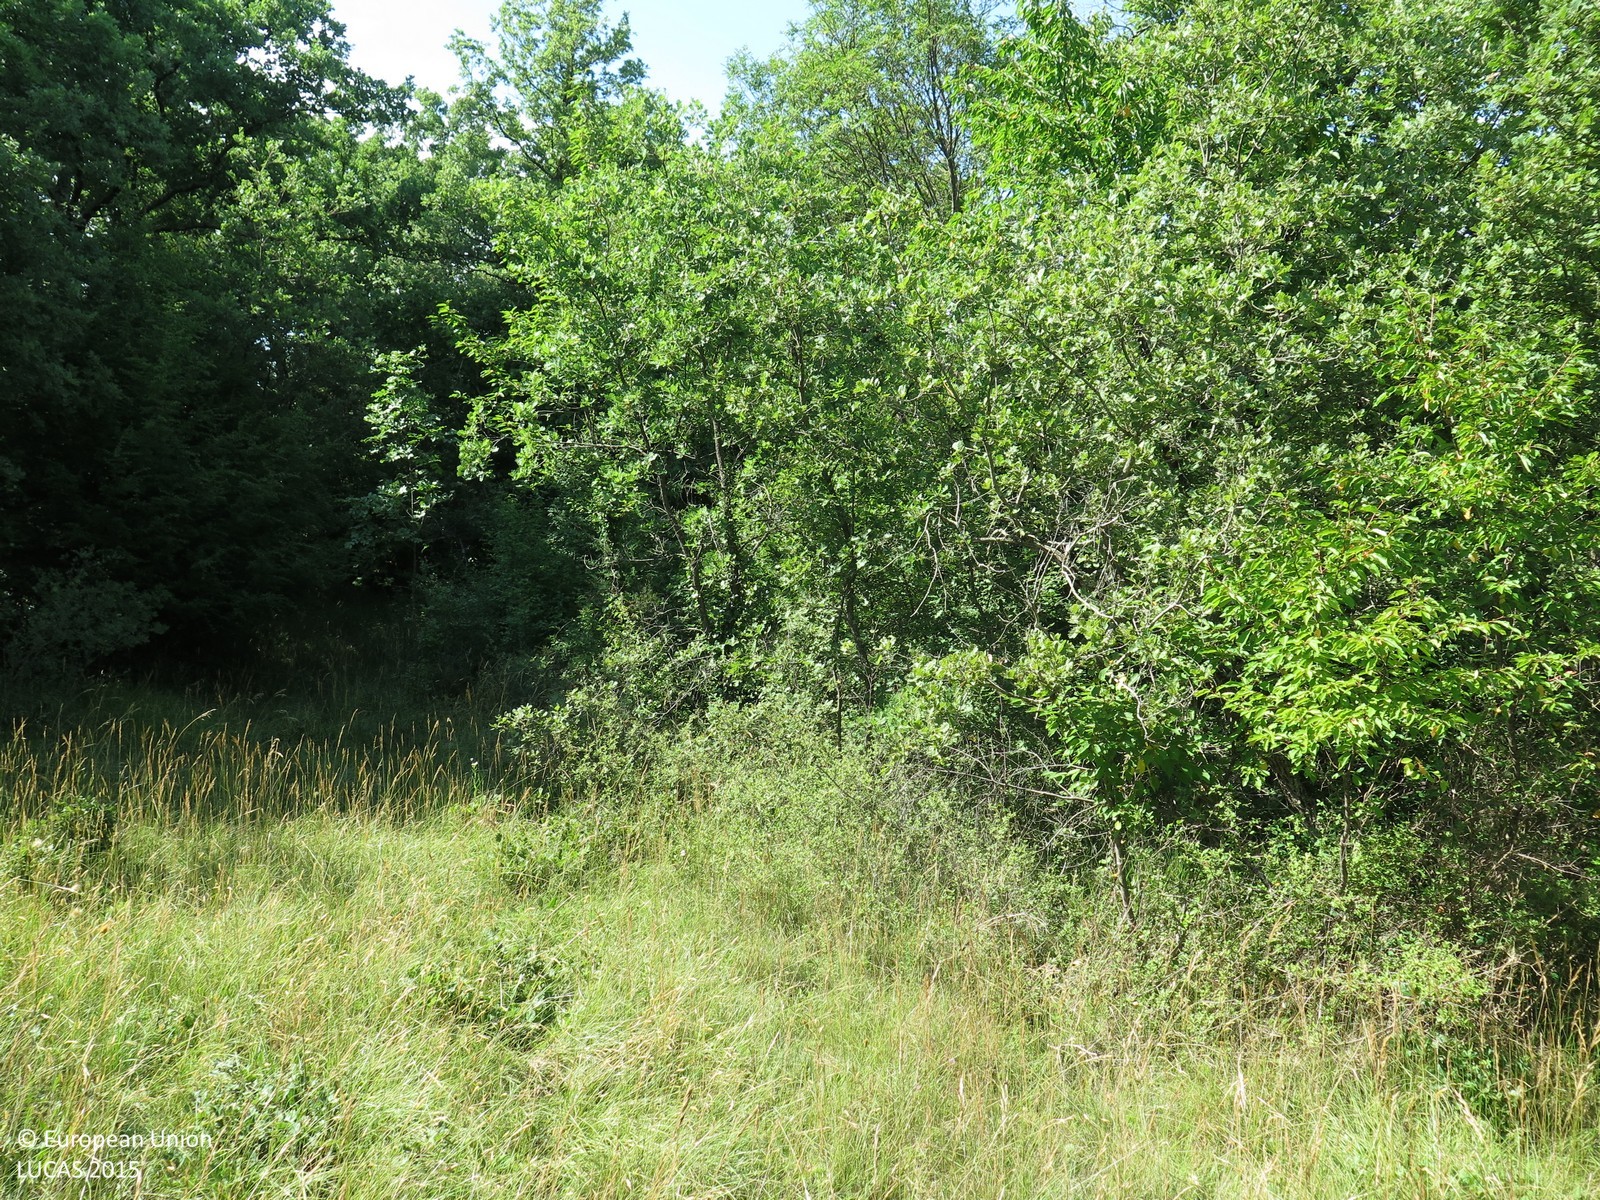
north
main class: Woodland
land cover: Broadleaved woodland
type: mesophytic deciduous forest
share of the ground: > 75 %
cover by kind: broadleaved forest trees 90 %, shrubs 5 %, herbaceous plants 5 %
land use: Semi-natural and natural areas not in use
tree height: > 5 m
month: June
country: HR
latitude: 45.2393
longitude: 13.7529
